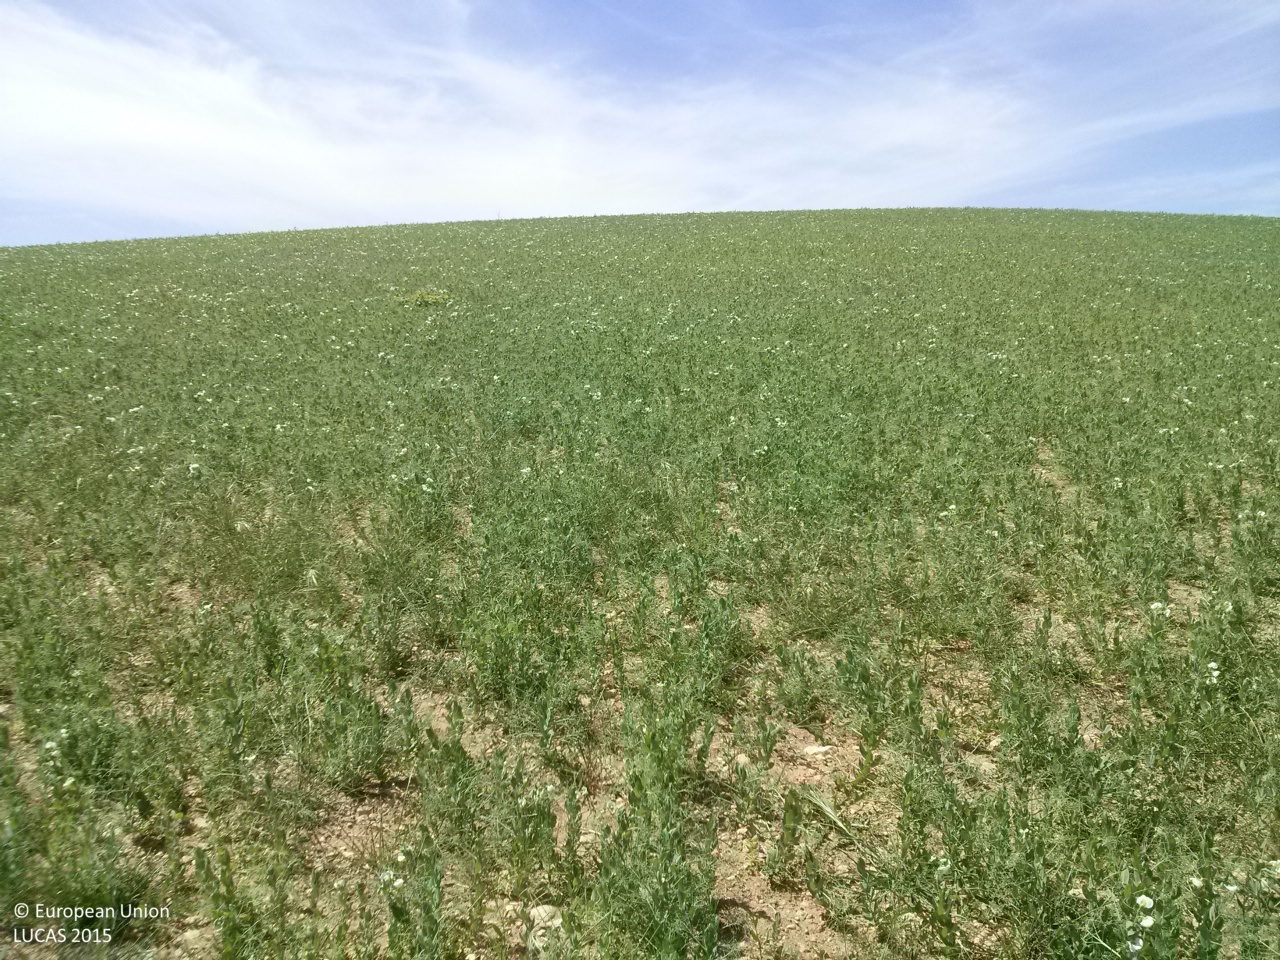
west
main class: Cropland
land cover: Dry pulses
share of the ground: > 75 %
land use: Agriculture (excluding fallow land and kitchen gardens)
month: May
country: ES
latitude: 39.7311
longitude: -2.6997
